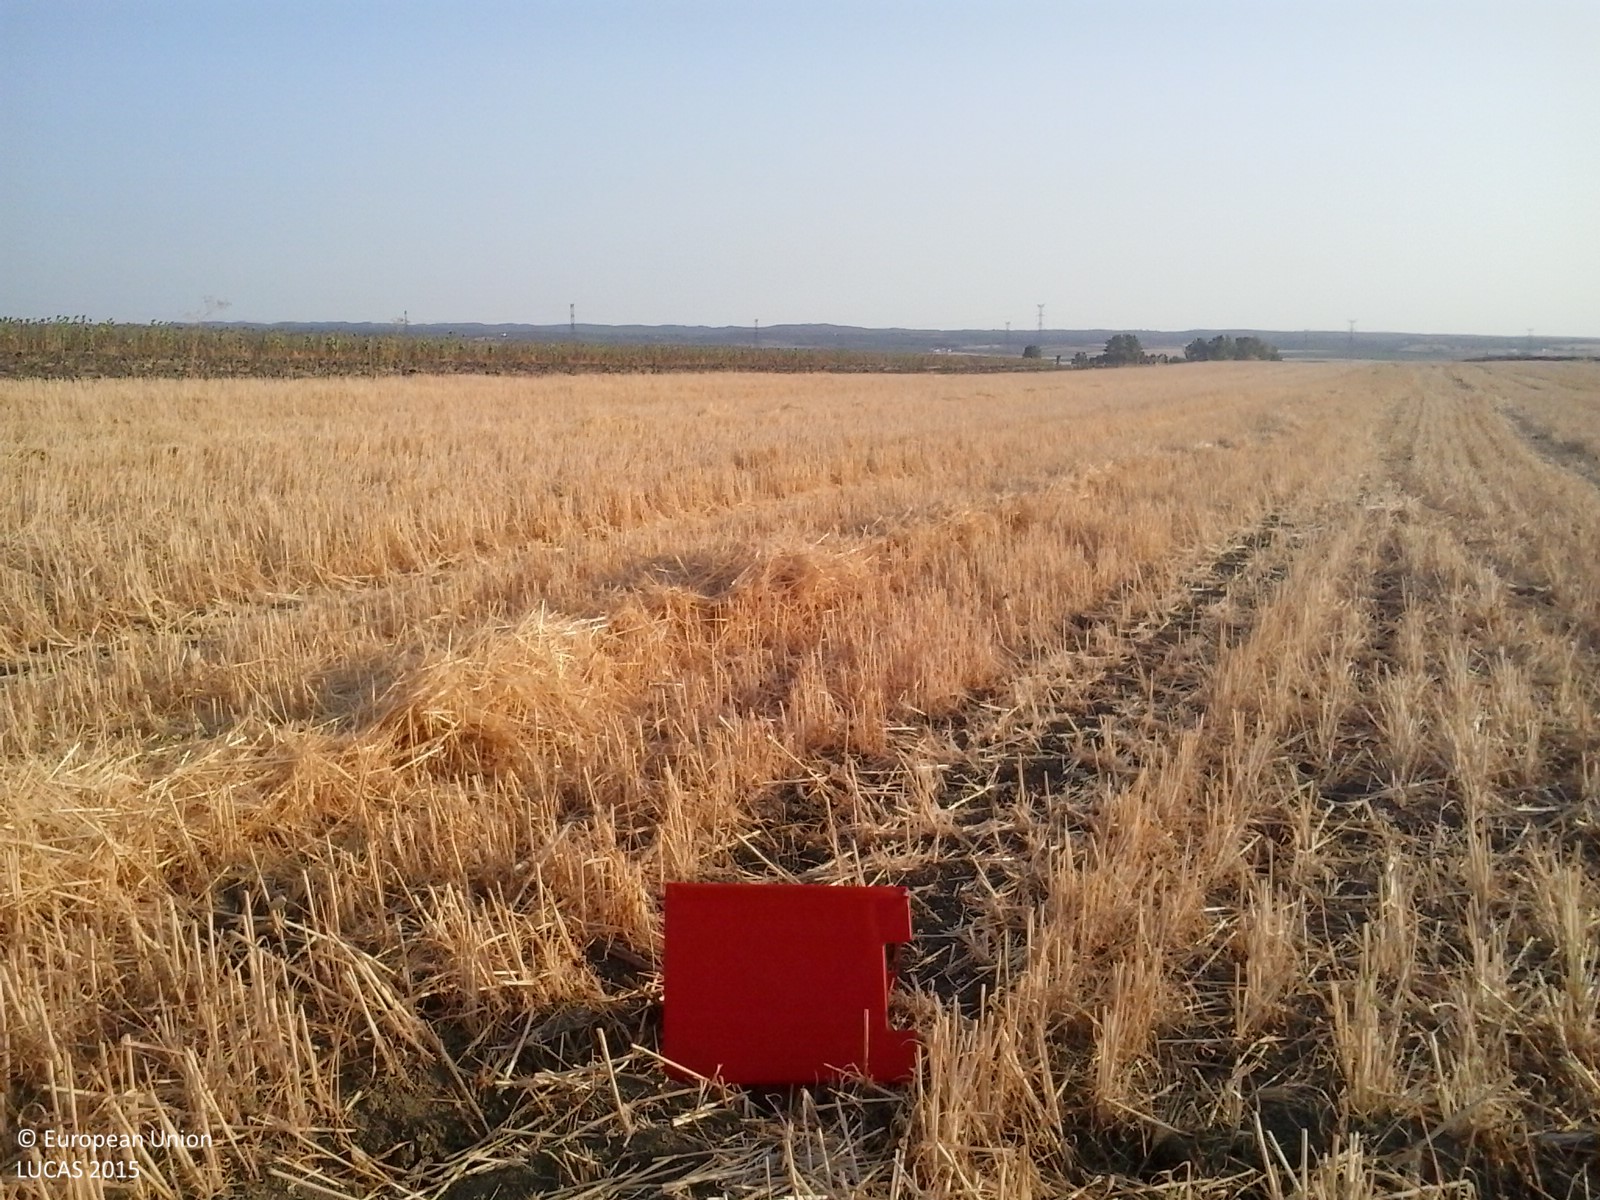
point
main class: Cropland
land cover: Common wheat
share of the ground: < 10 %
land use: Agriculture (excluding fallow land and kitchen gardens)
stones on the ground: < 10 %
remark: Harvested field
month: July
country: ES
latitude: 37.4412
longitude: -6.3864
